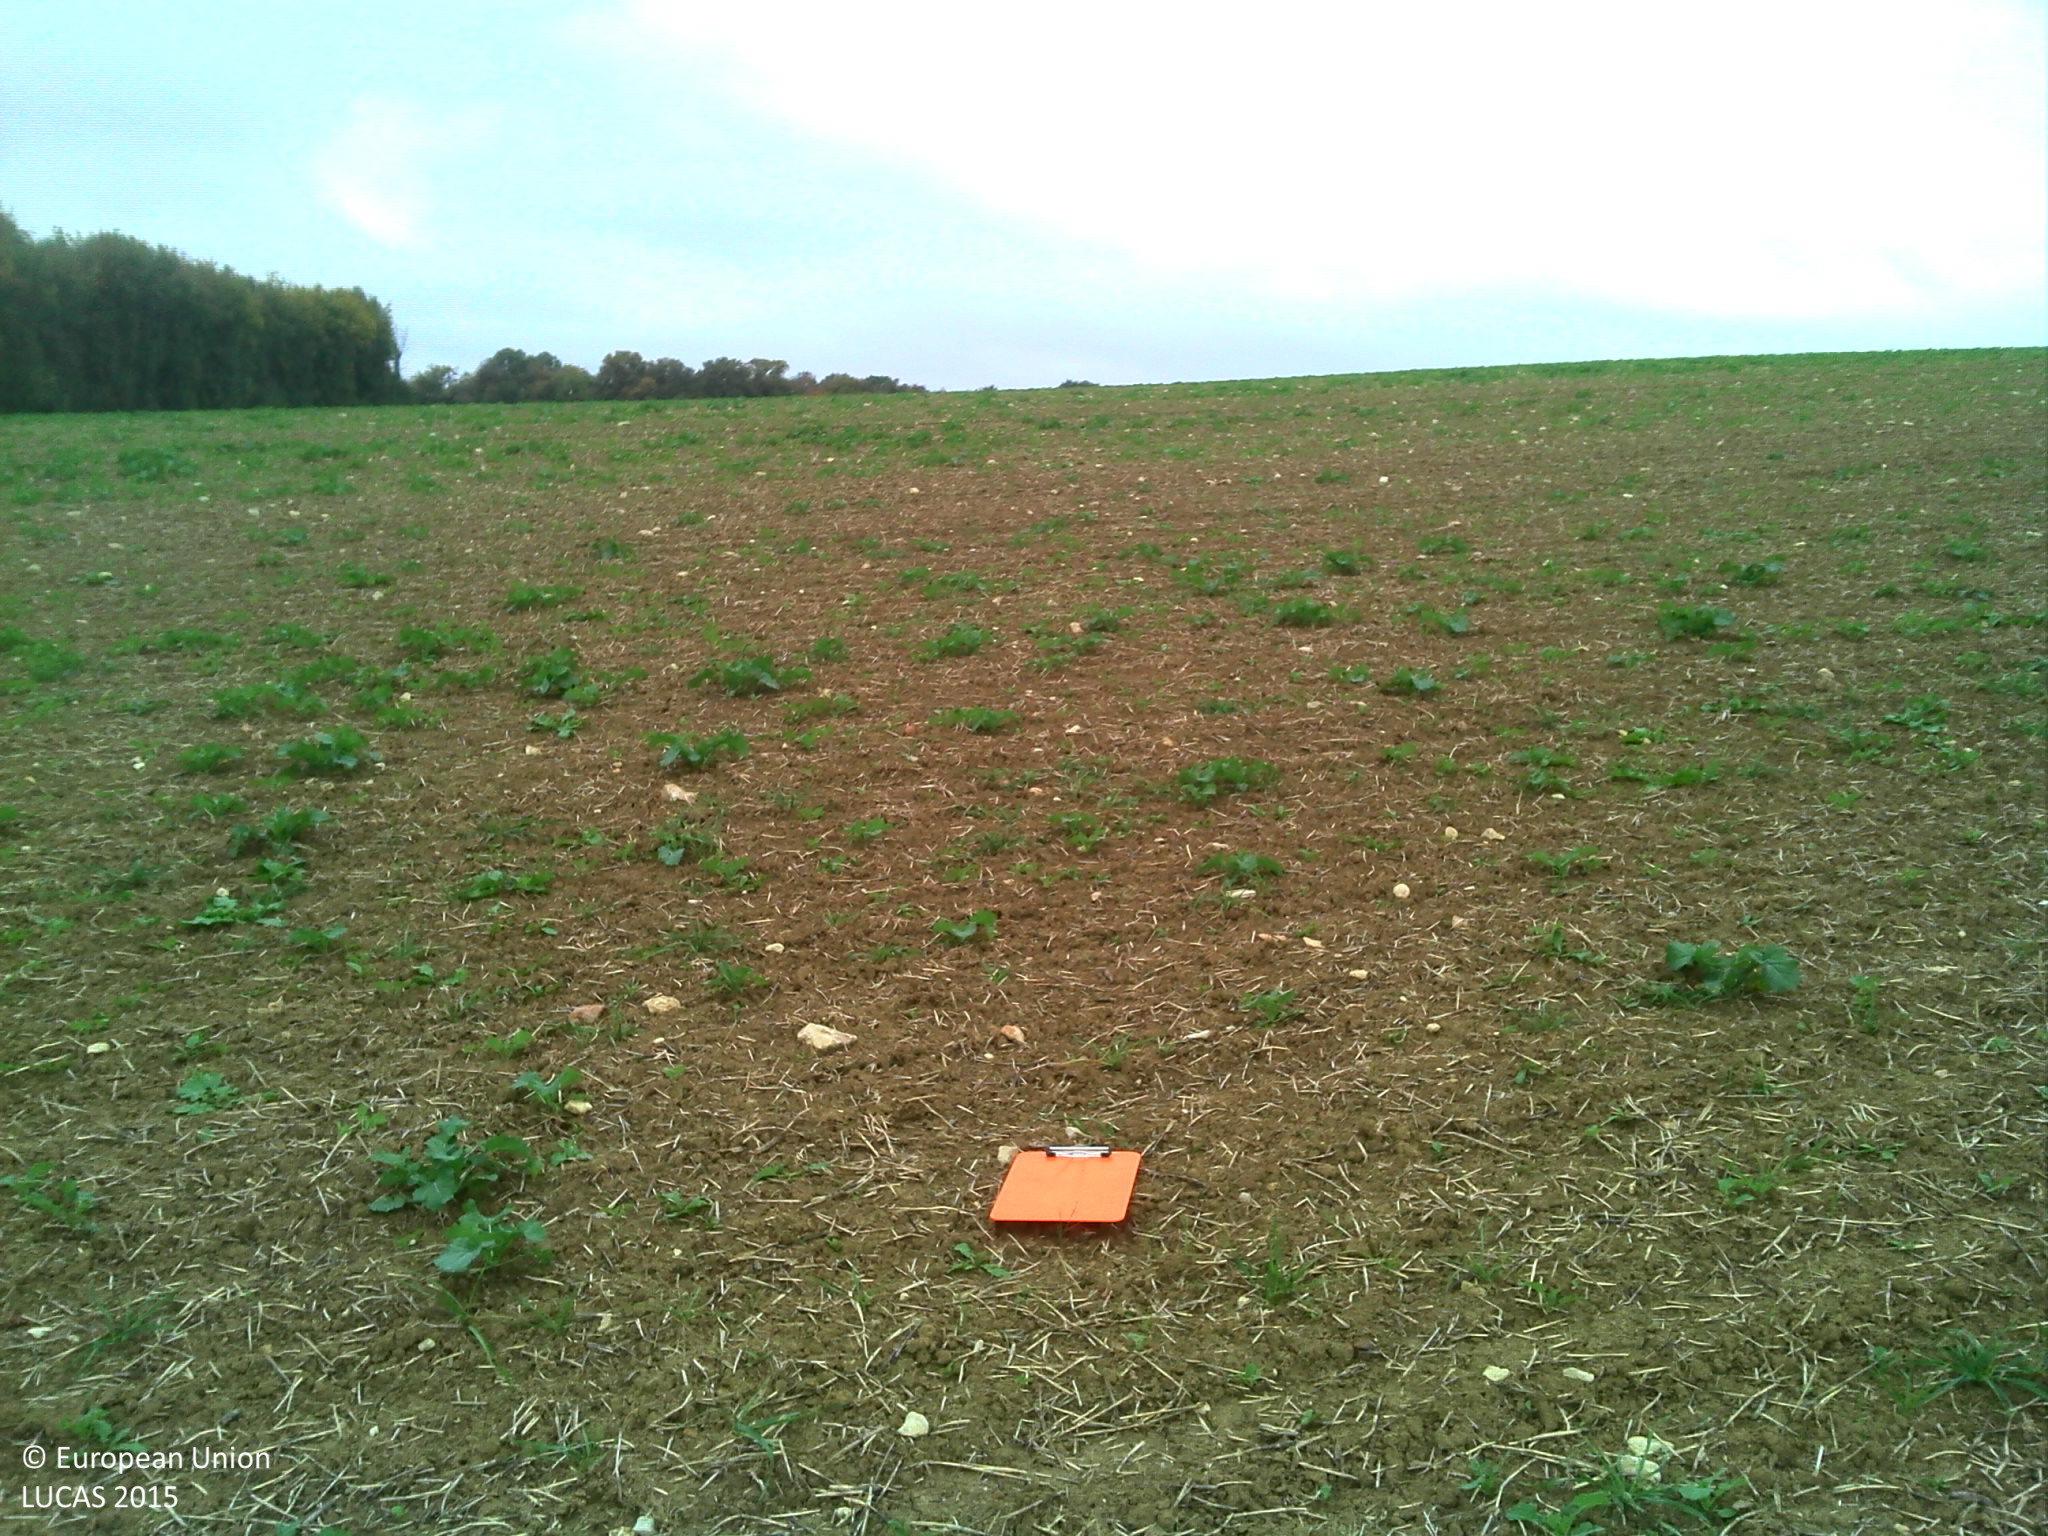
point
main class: Cropland
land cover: Rape and turnip rape
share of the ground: 10 - 25 %
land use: Agriculture (excluding fallow land and kitchen gardens)
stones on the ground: < 10 %
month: October
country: FR
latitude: 47.3898
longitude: 5.4305
